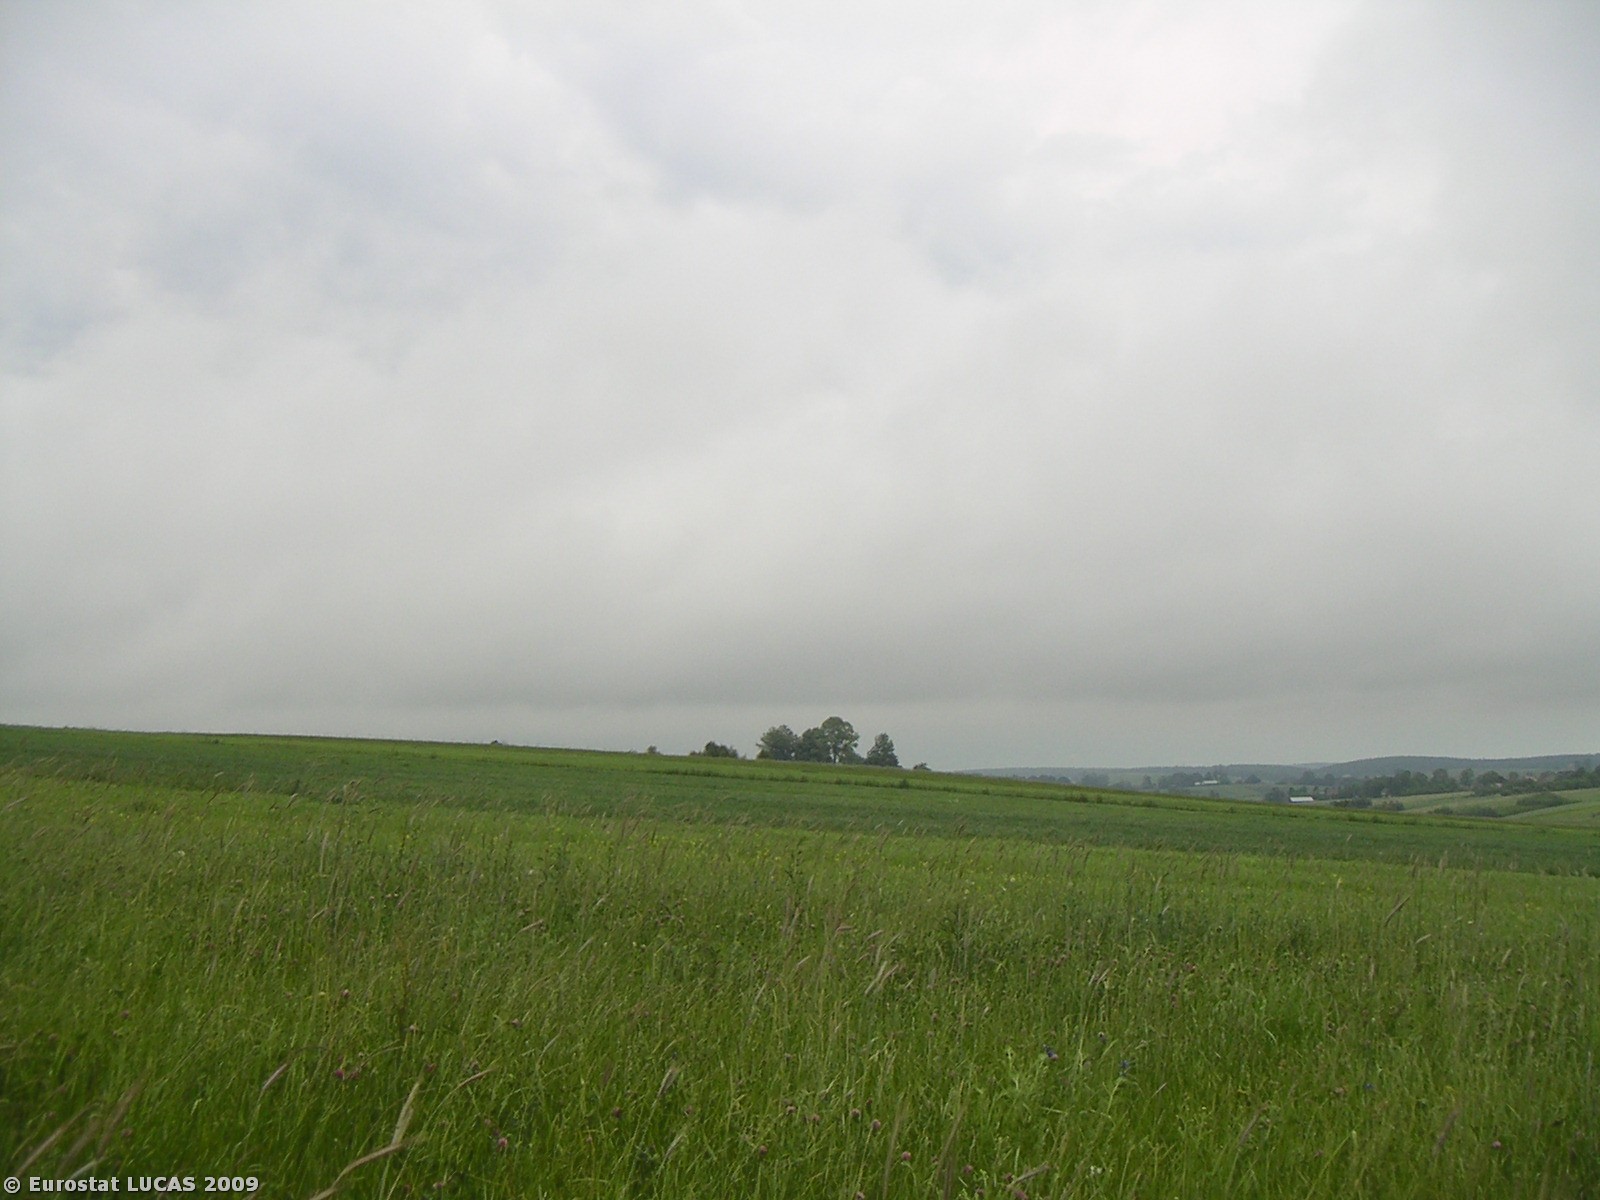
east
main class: Cropland
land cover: Clovers
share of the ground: 10 - 25 %
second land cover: Grassland without tree/shrub cover
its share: 25 - 50 %
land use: Agriculture (excluding fallow land and kitchen gardens)
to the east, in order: Clovers; Common wheat; Oats; Common wheat; Oats; Common wheat; Oats; Rye
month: June
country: PL
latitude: 50.2700
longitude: 19.7811
